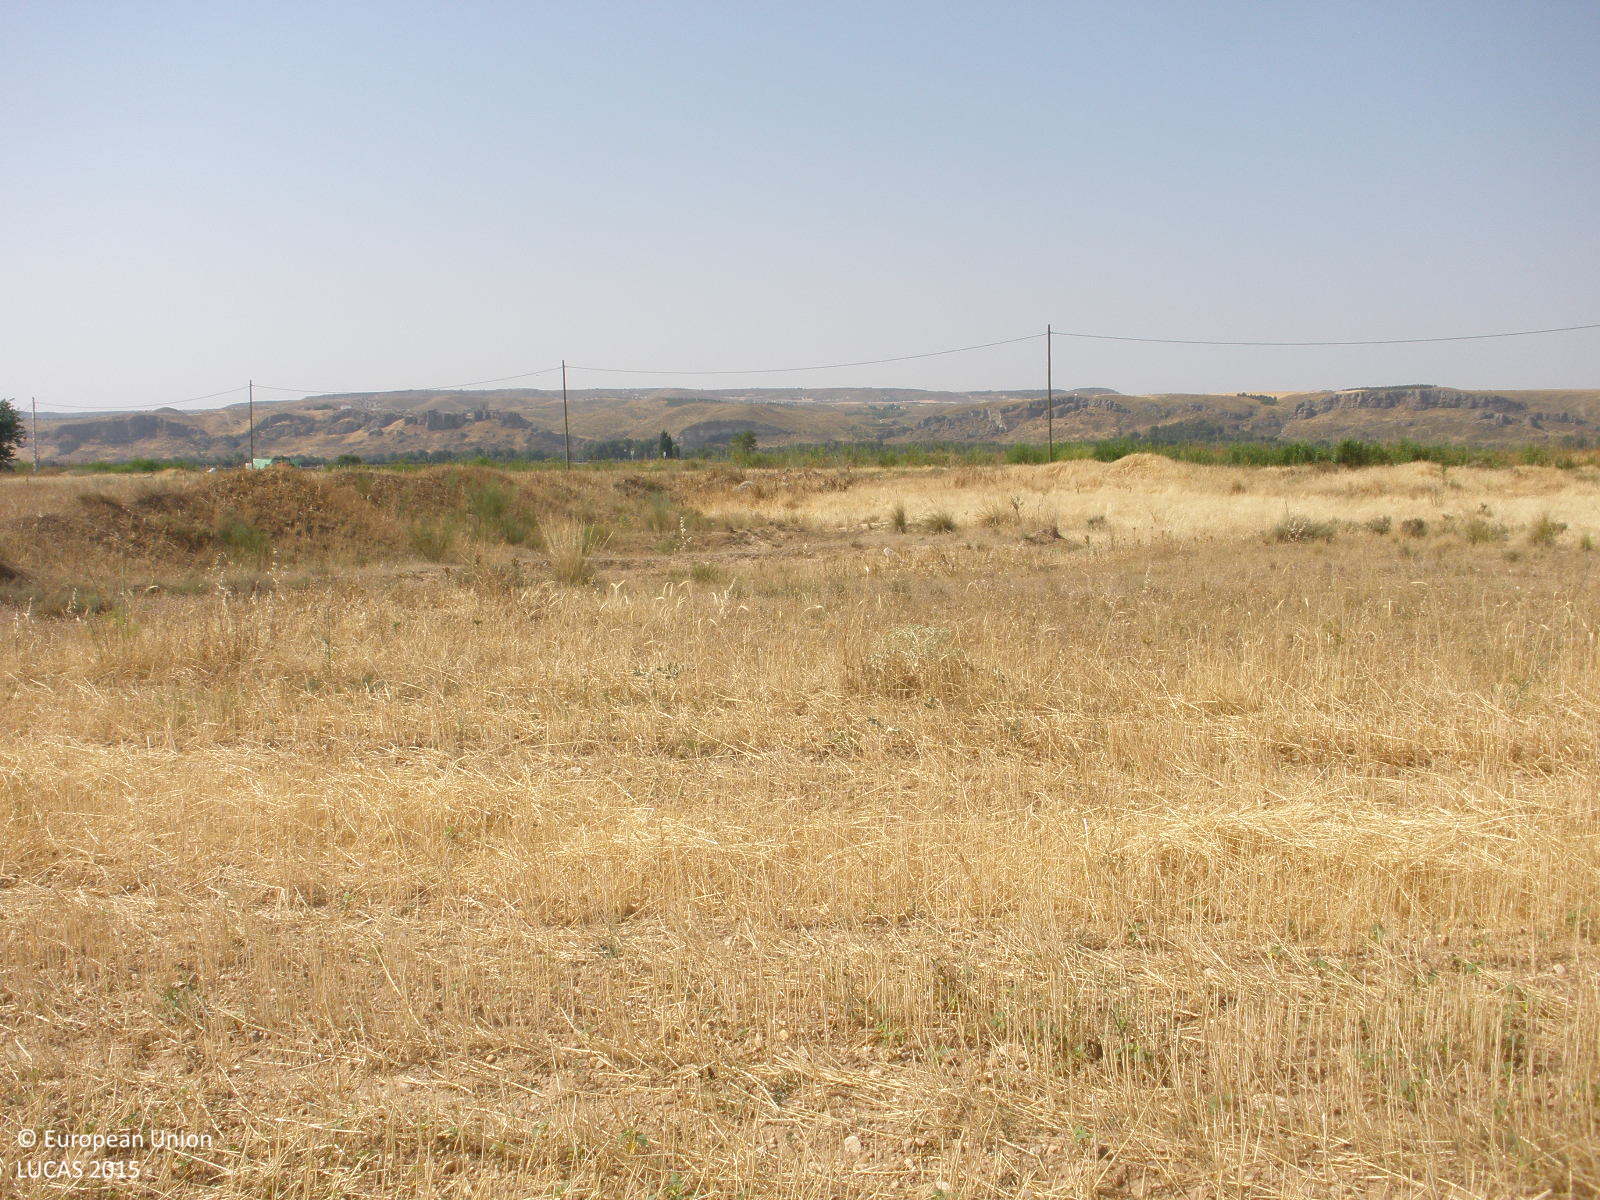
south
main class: Cropland
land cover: Barley
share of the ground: < 10 %
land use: Agriculture (excluding fallow land and kitchen gardens)
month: July
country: ES
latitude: 40.0620
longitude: -3.5010
